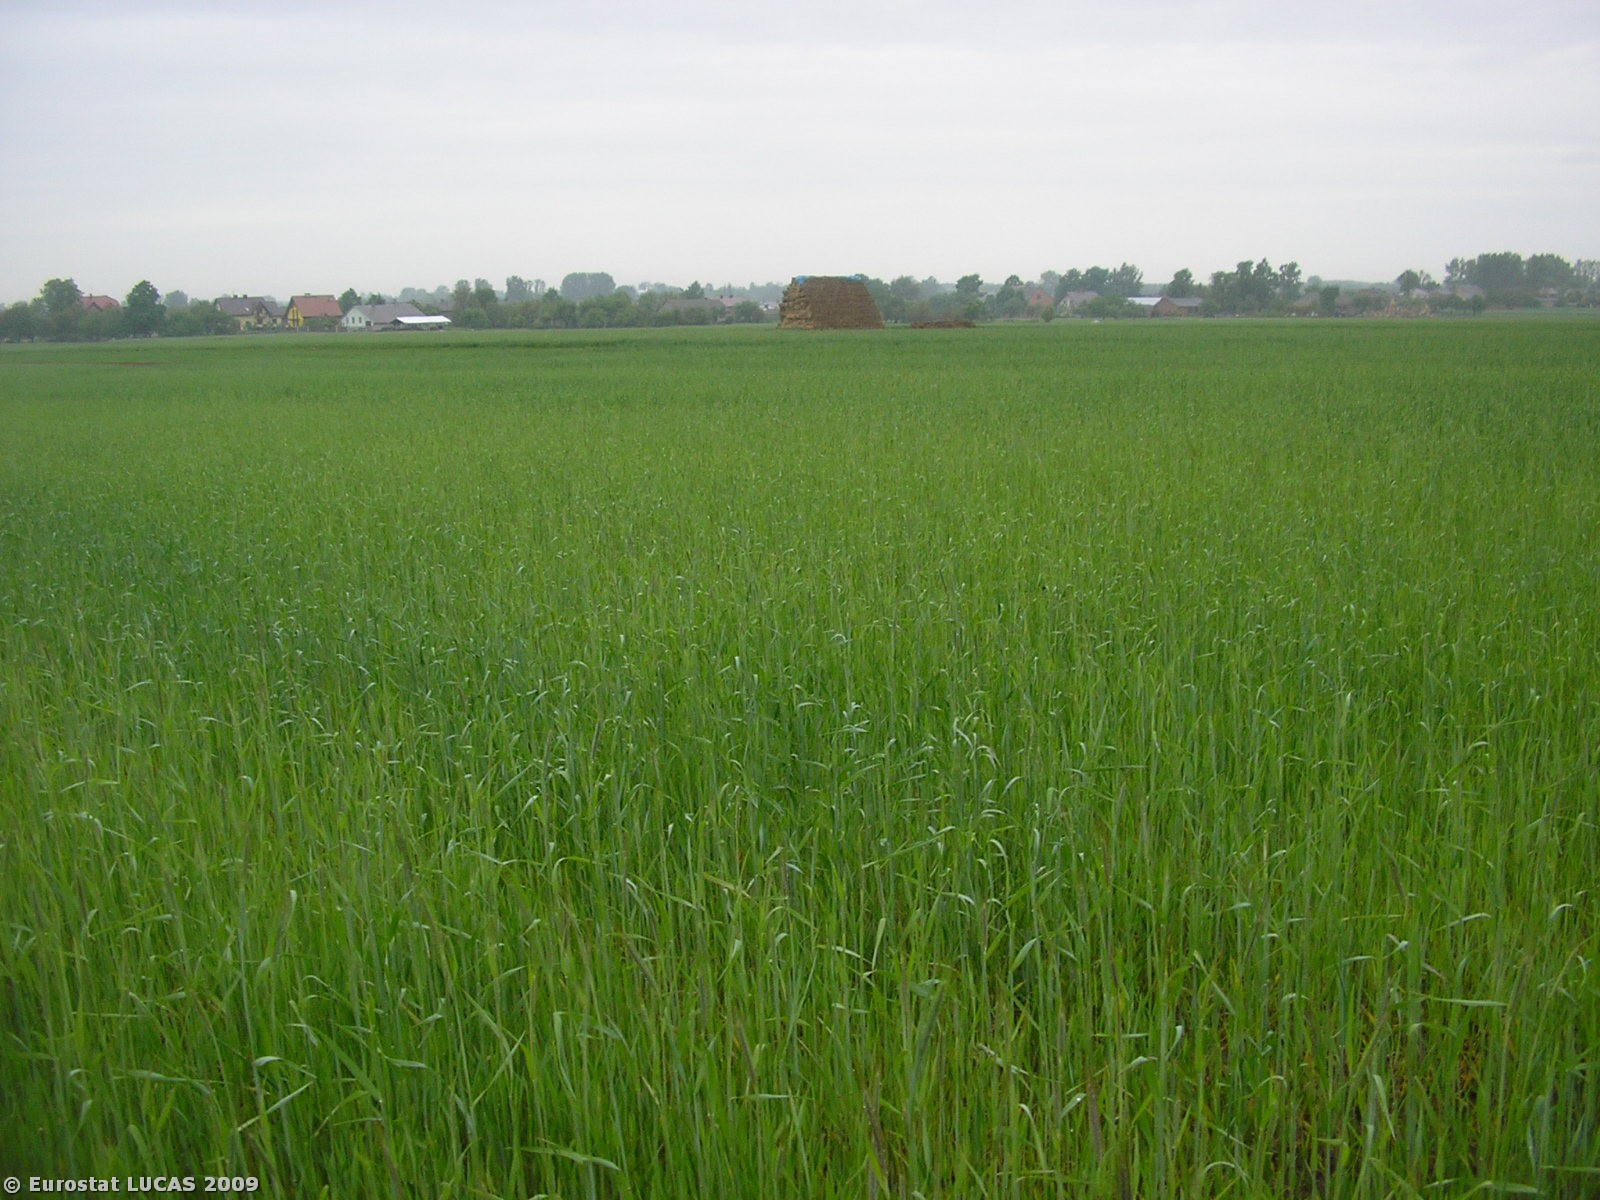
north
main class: Cropland
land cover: Rye
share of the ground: > 75 %
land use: Agriculture (excluding fallow land and kitchen gardens)
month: May
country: PL
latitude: 51.7892
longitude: 20.0220
